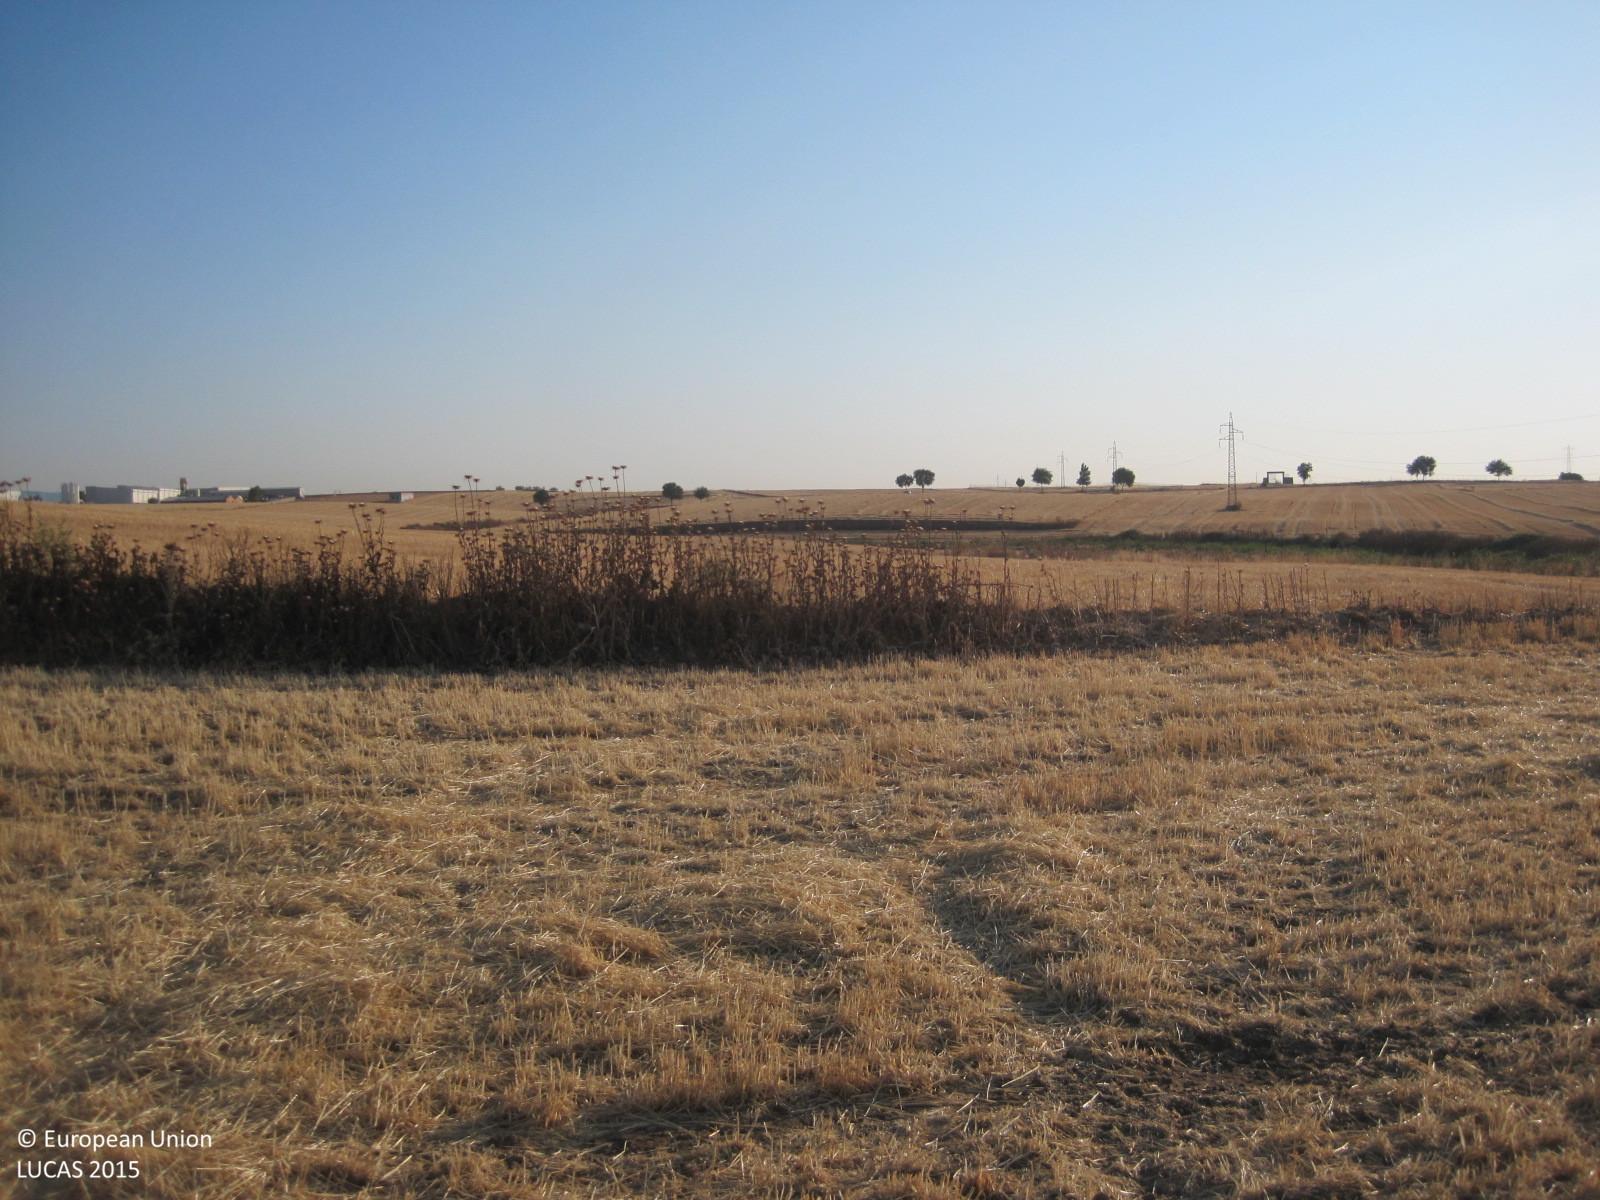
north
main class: Cropland
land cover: Barley
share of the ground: < 10 %
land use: Agriculture (excluding fallow land and kitchen gardens)
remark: Harvested field
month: July
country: ES
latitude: 40.1653
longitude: -3.8085
